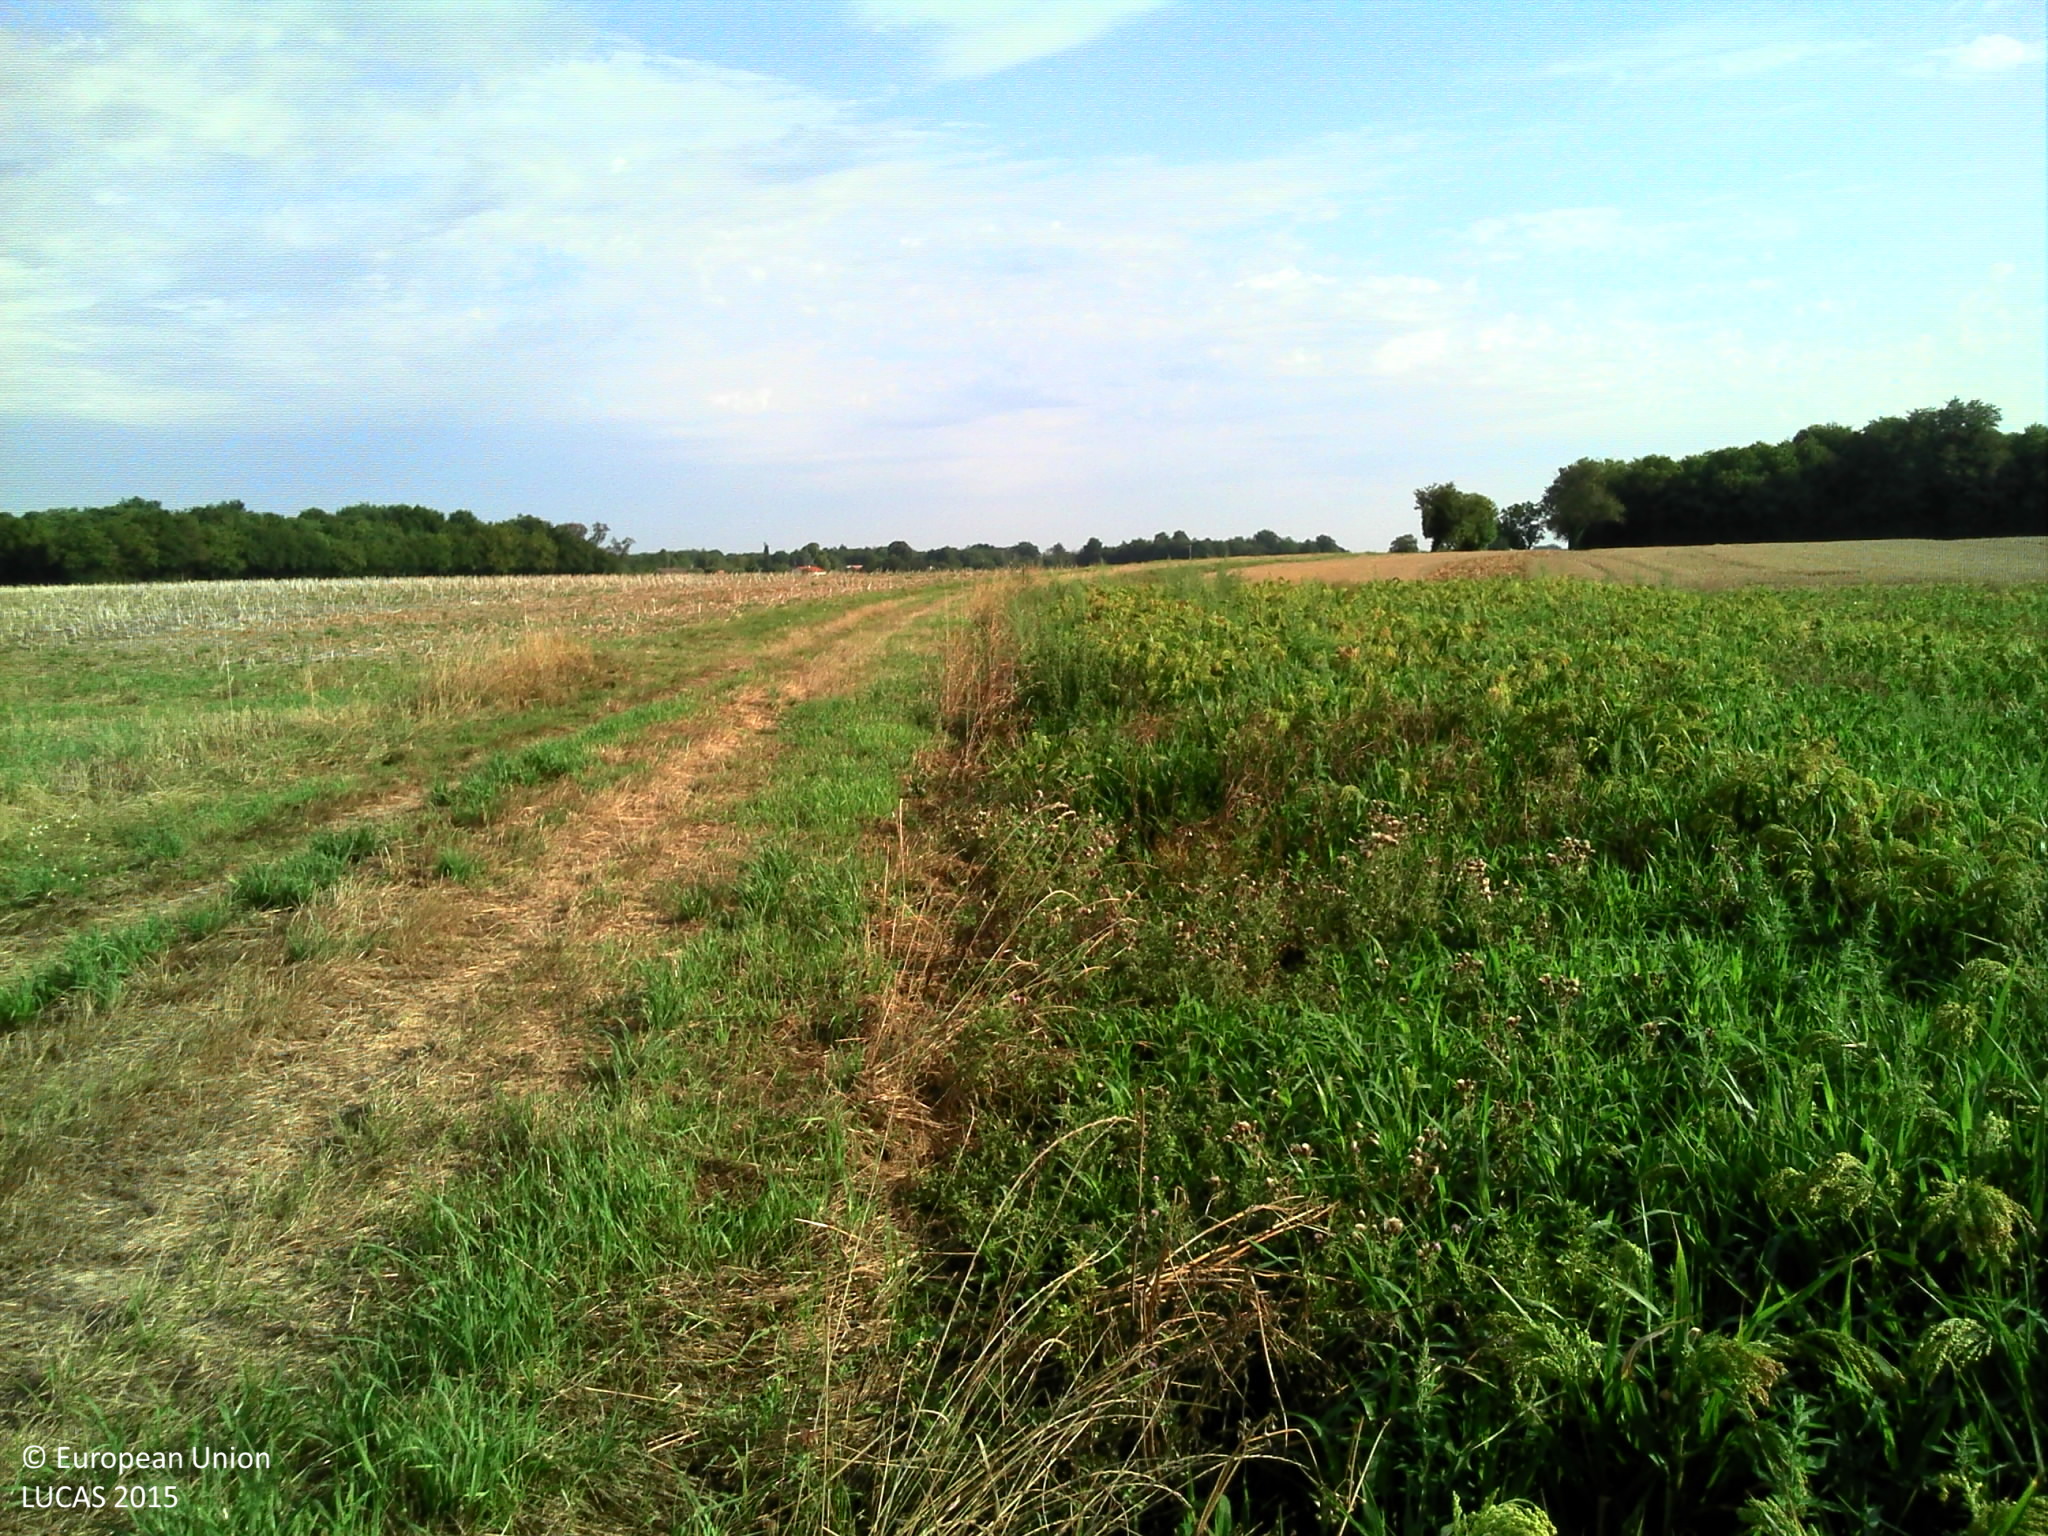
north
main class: Cropland
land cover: Other cereals
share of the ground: > 75 %
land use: Agriculture (excluding fallow land and kitchen gardens)
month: August
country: FR
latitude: 46.1819
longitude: 0.3050
